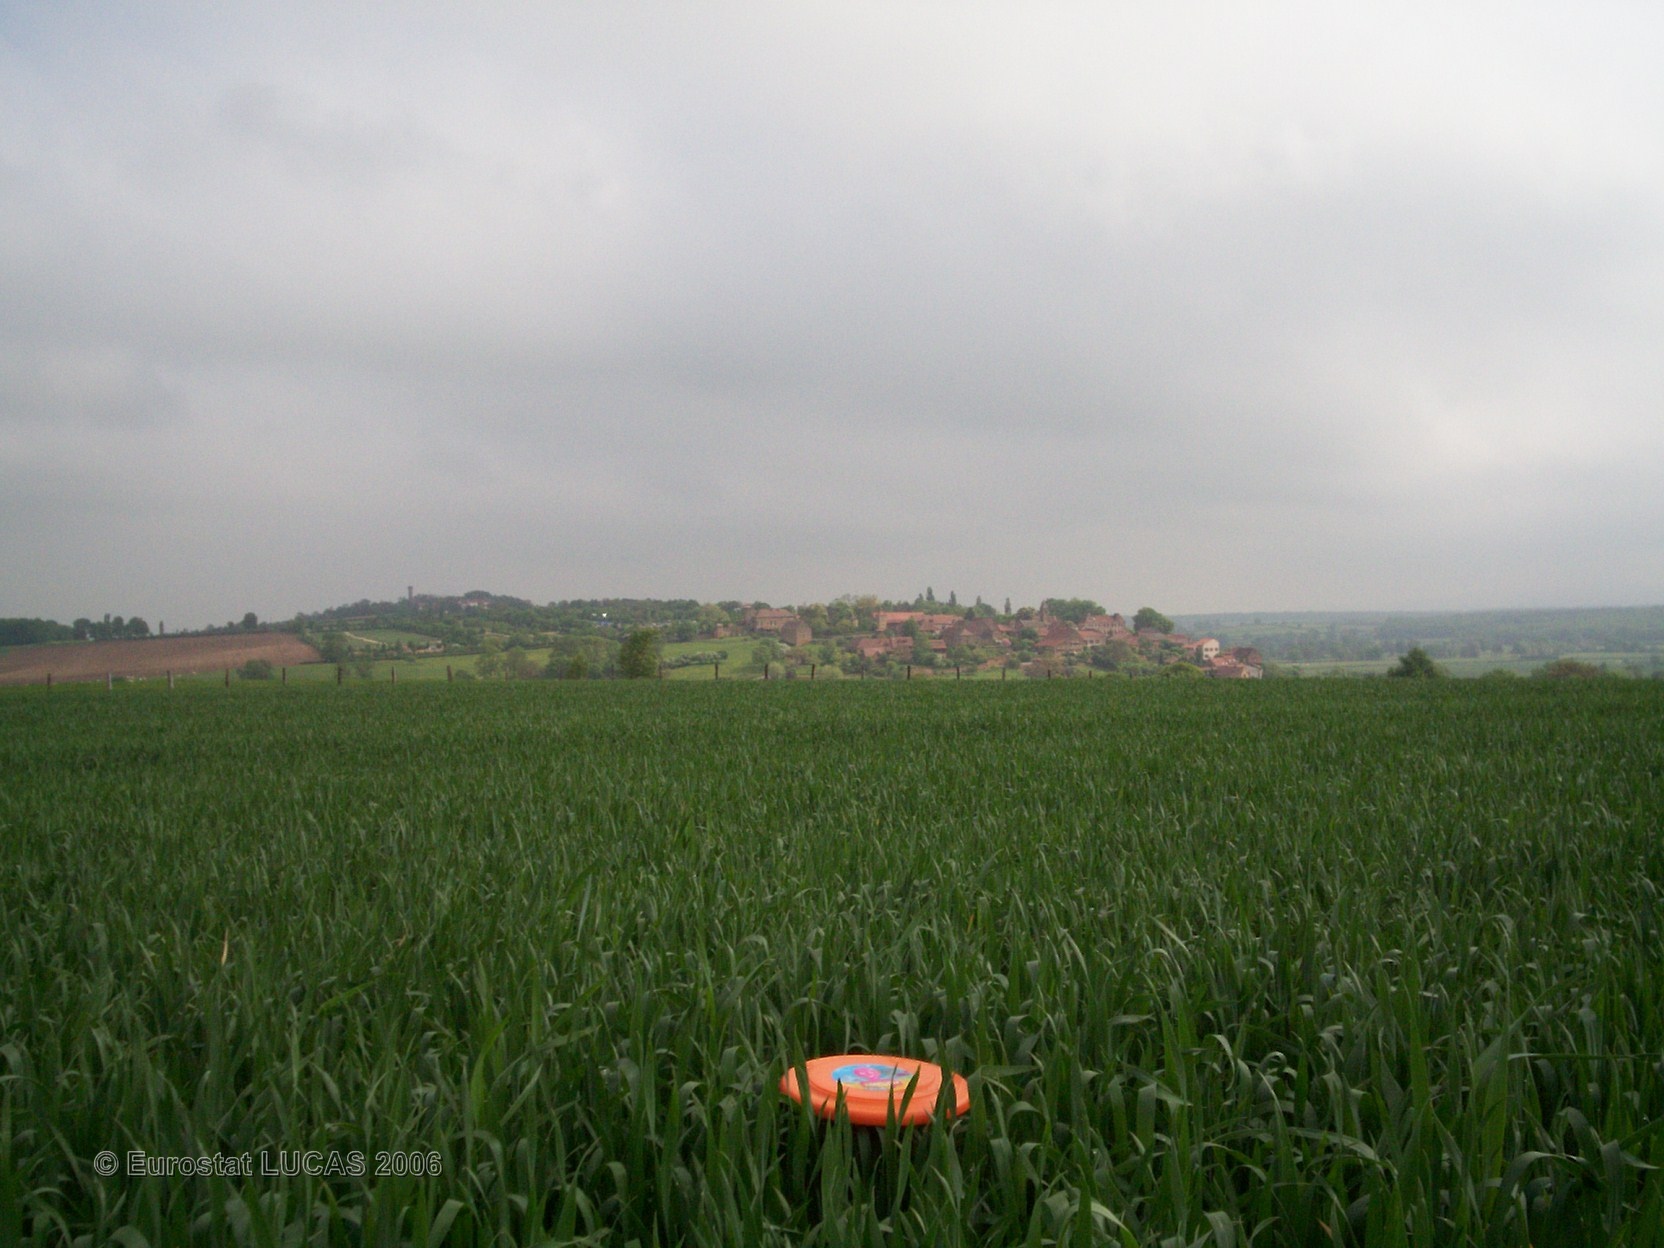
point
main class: Cropland
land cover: Common wheat
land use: Agriculture (excluding fallow land and kitchen gardens)
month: May
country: FR
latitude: 46.5072
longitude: 4.6715
